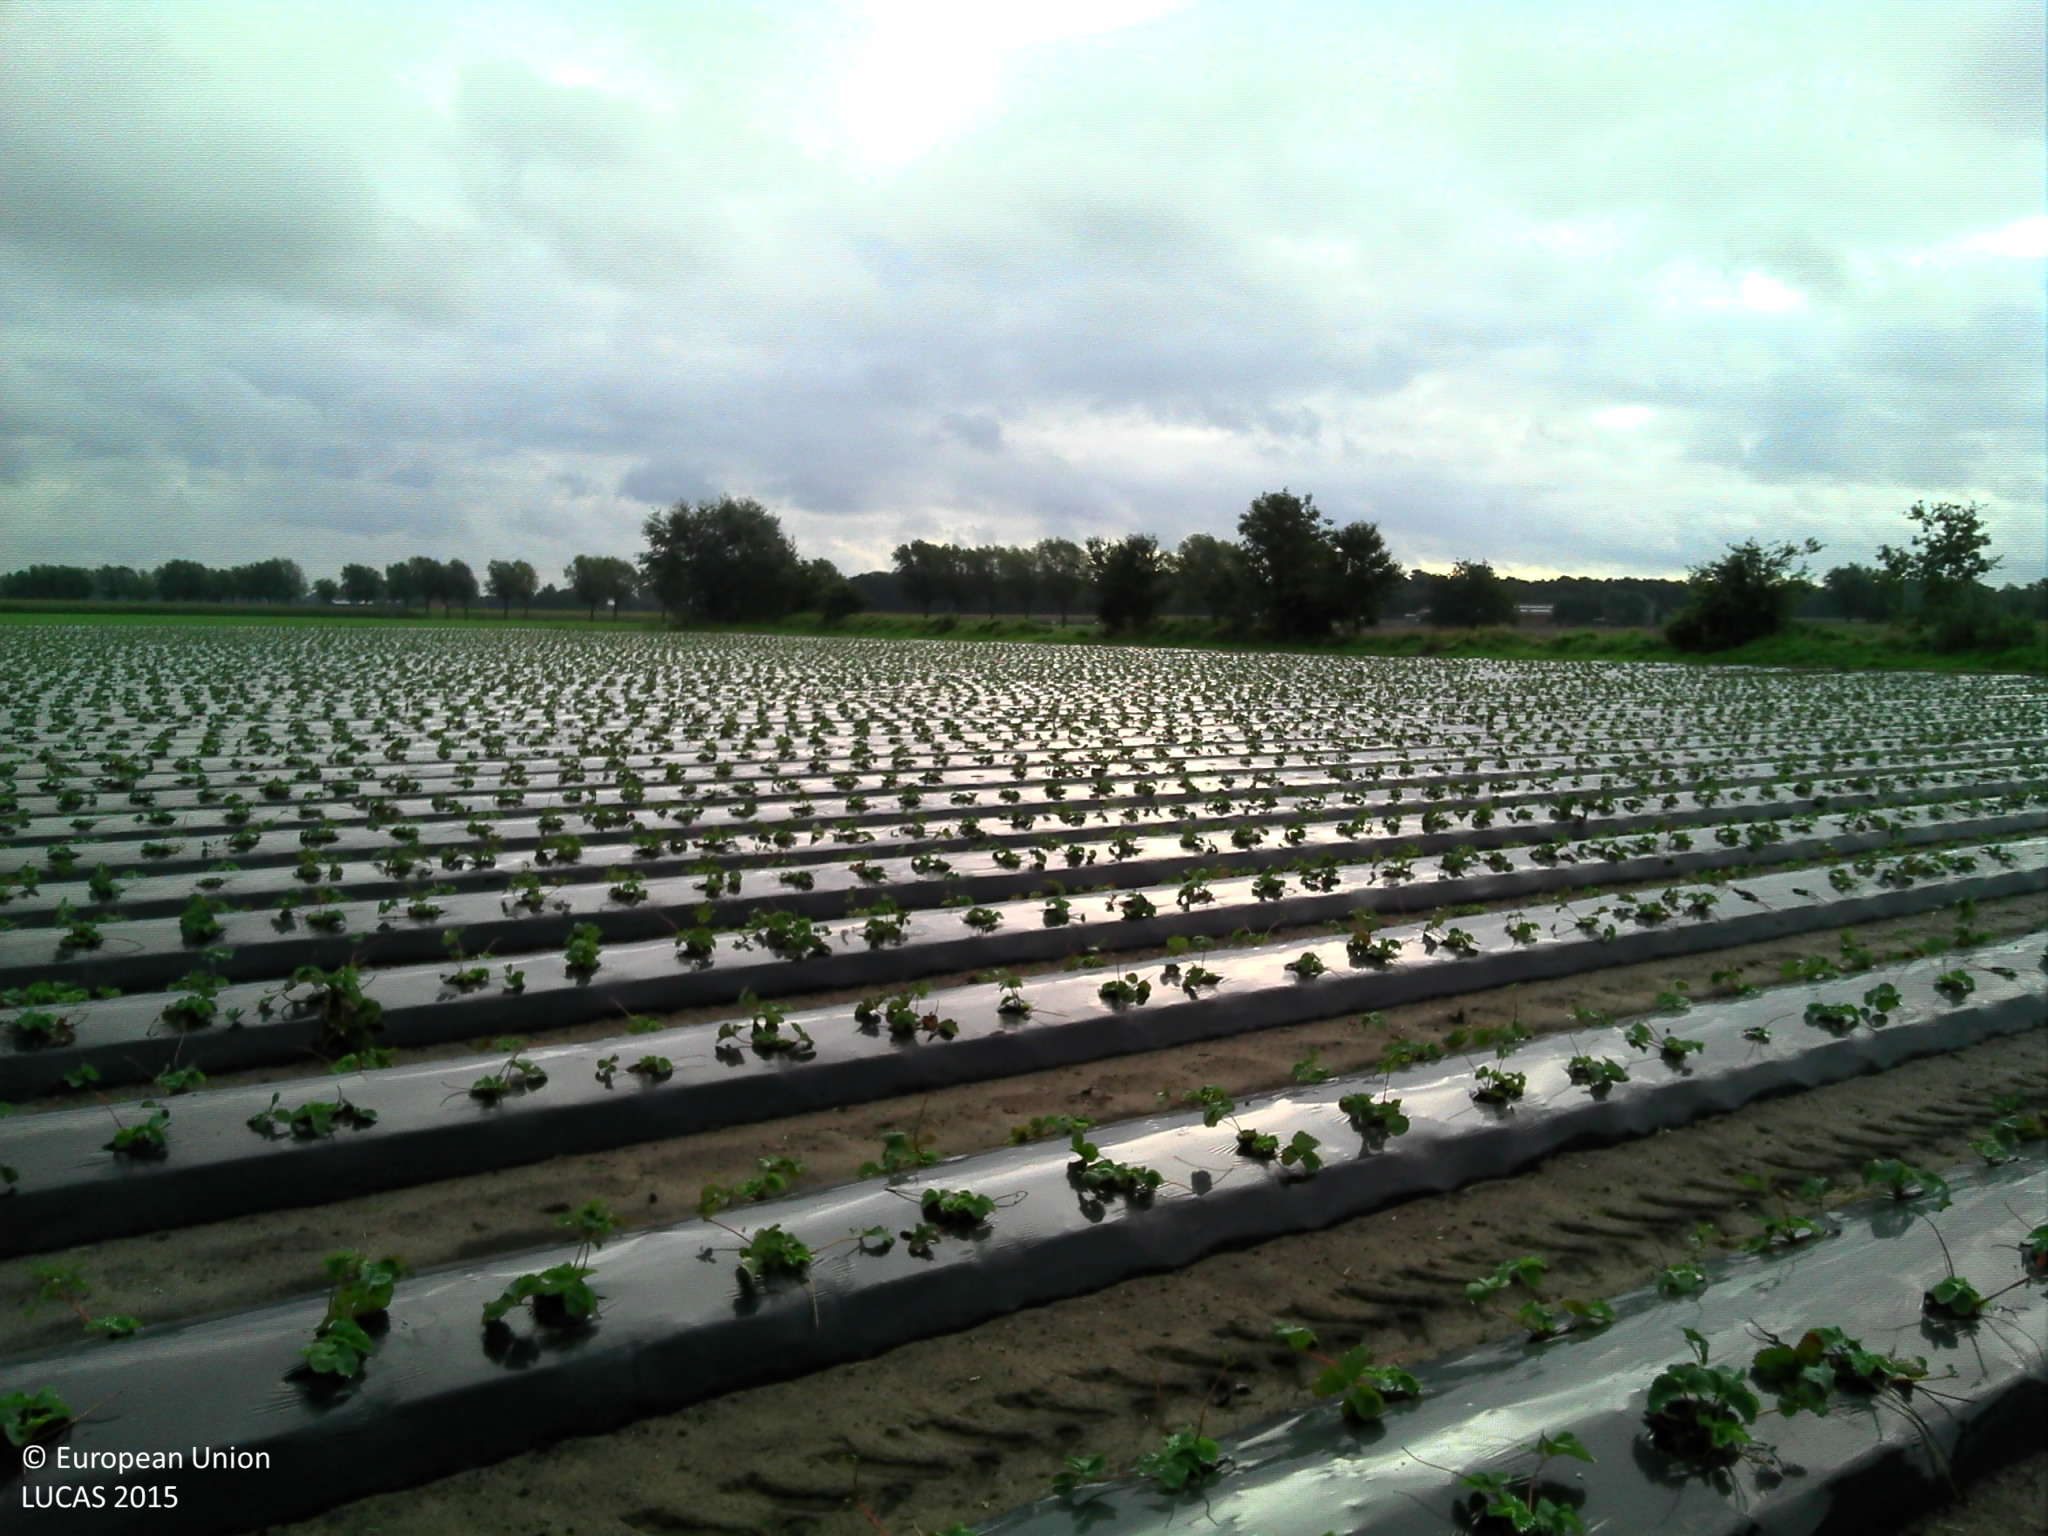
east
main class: Cropland
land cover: Strawberries
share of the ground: < 10 %
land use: Agriculture (excluding fallow land and kitchen gardens)
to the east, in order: Strawberries; Other bare soil; Grass margins; Abandoned hedges; Ditches and canals; Grass margins; Temporary grasslands; Grass margins; Ditches and canals; Temporary grasslands
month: September
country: BE
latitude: 51.4863
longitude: 4.7400
